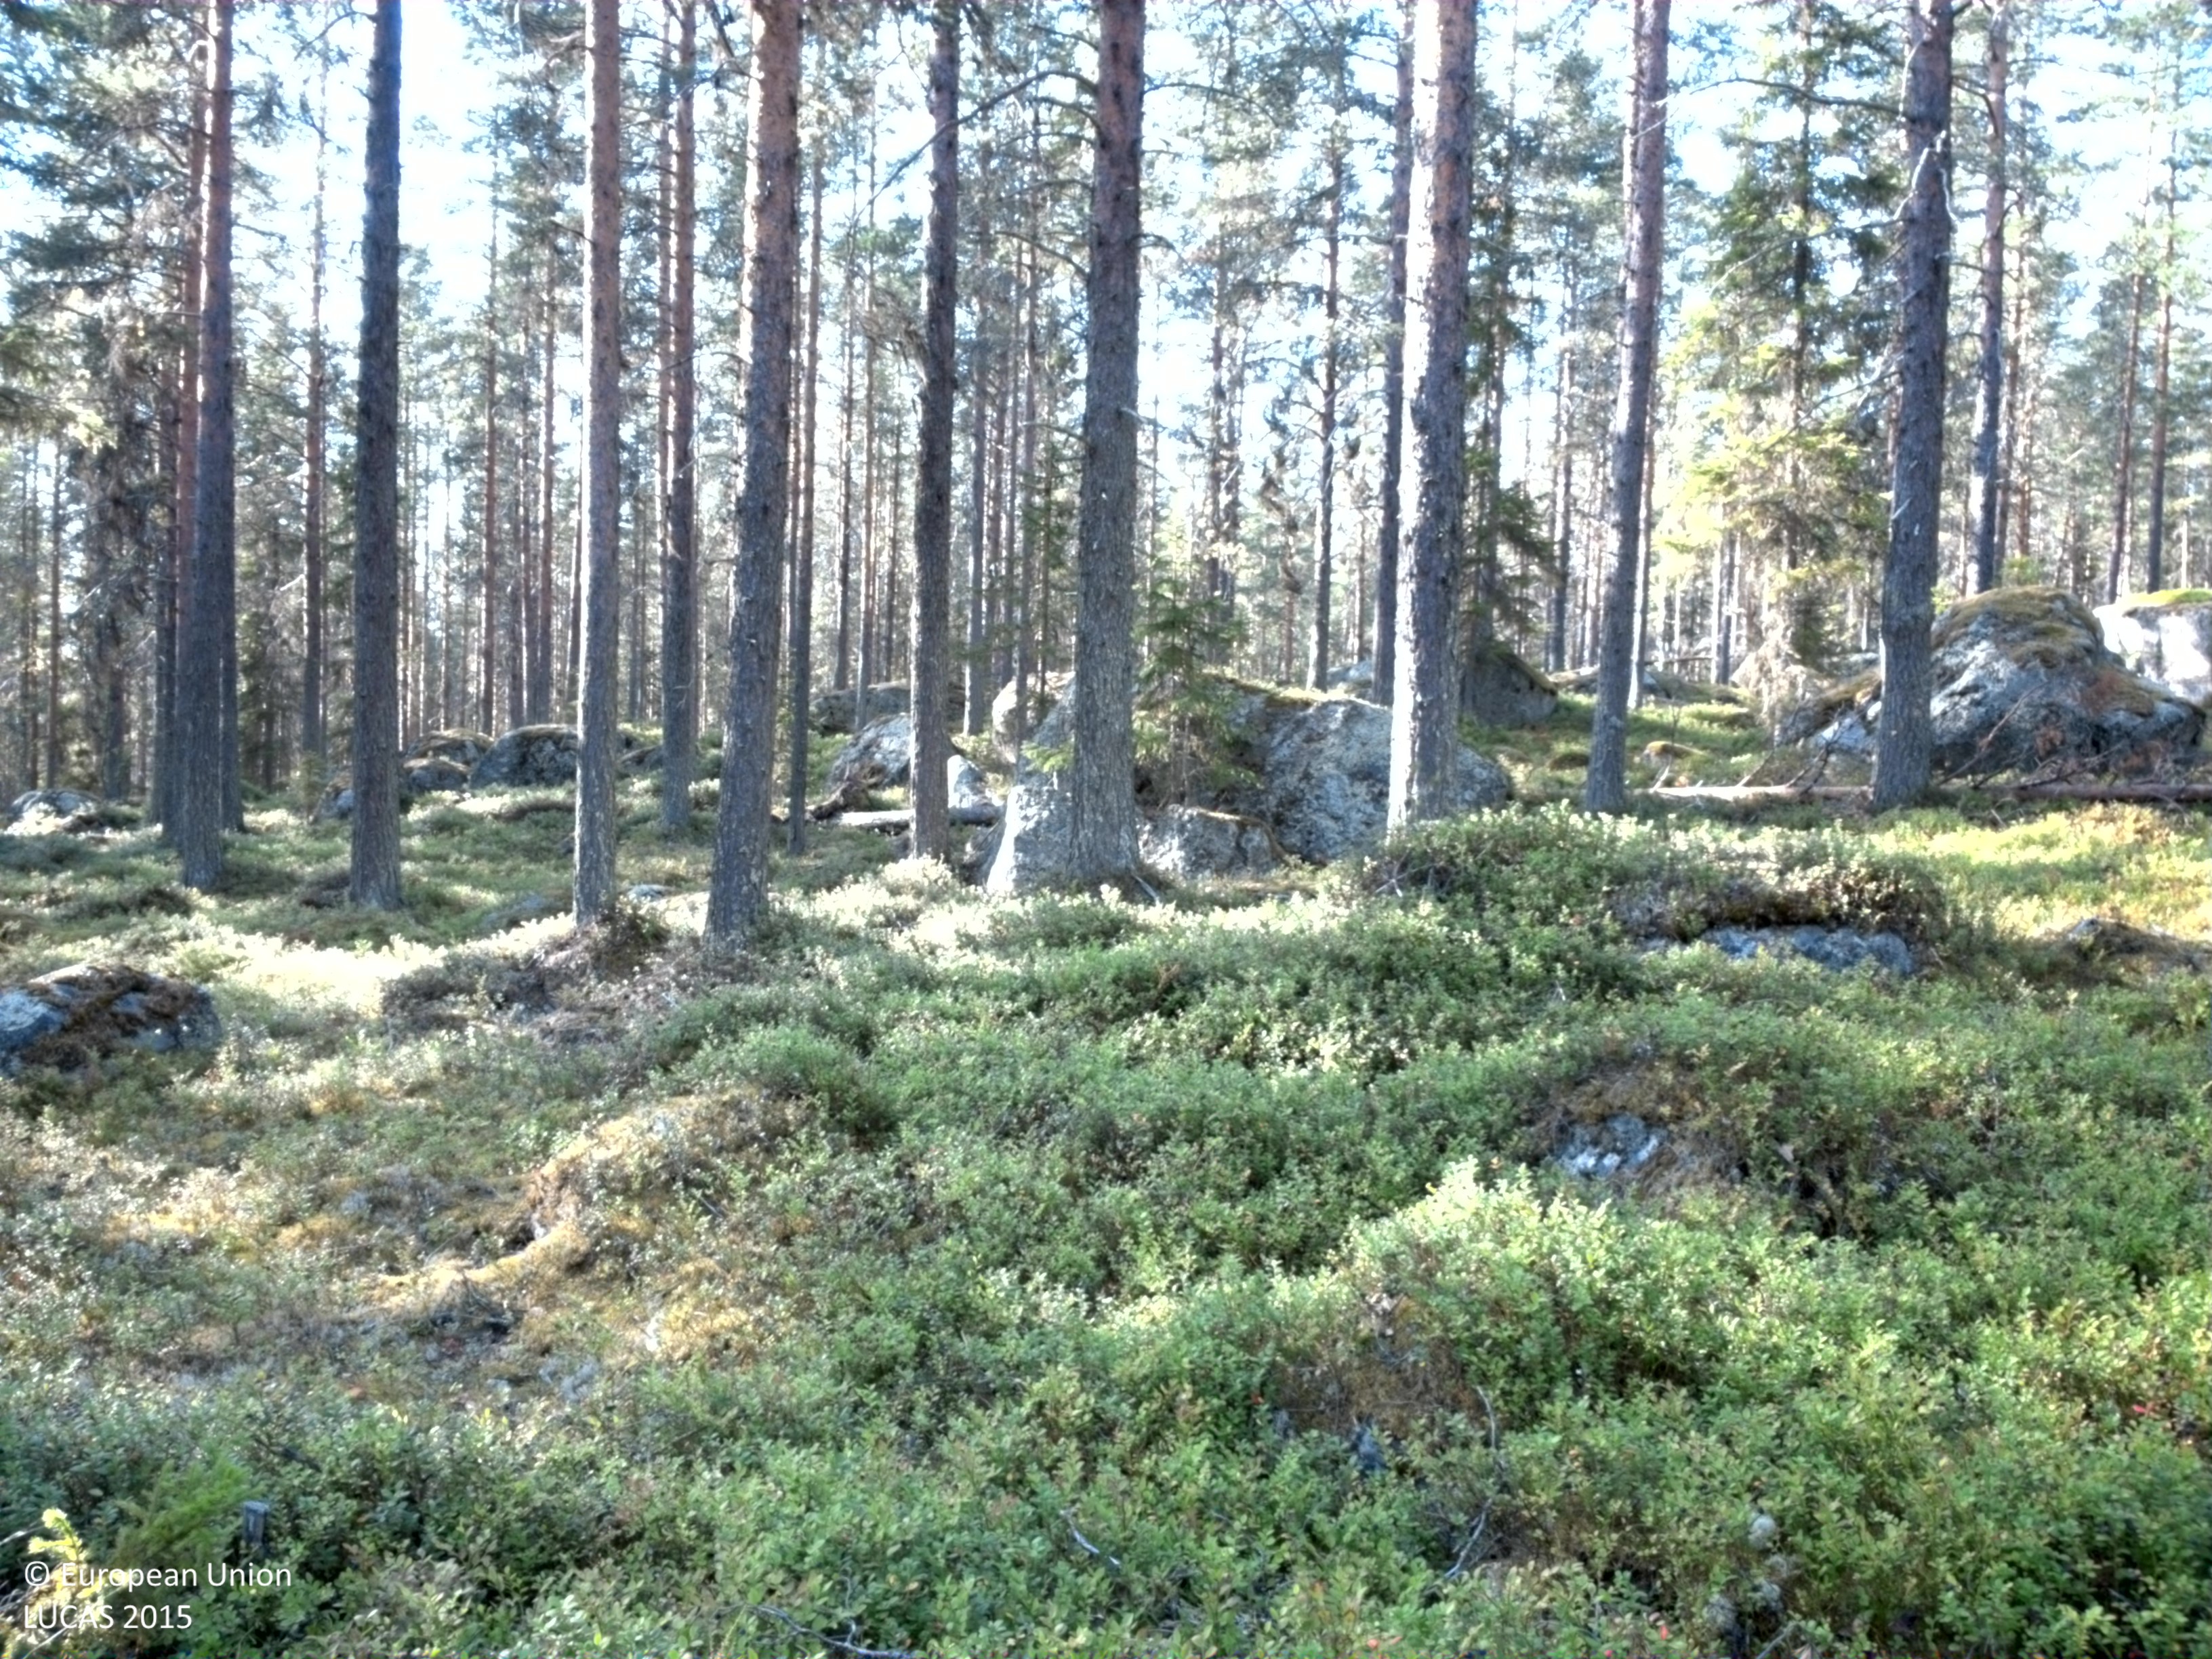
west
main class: Woodland
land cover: Pine dominated coniferous woodland
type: boreal forest
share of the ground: 50 - 75 %
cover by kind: coniferous forest trees 50 %, shrubs 45 %, lichens and mosses 5 %
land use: Forestry
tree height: > 5 m
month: August
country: SE
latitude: 64.4782
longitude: 18.8518
